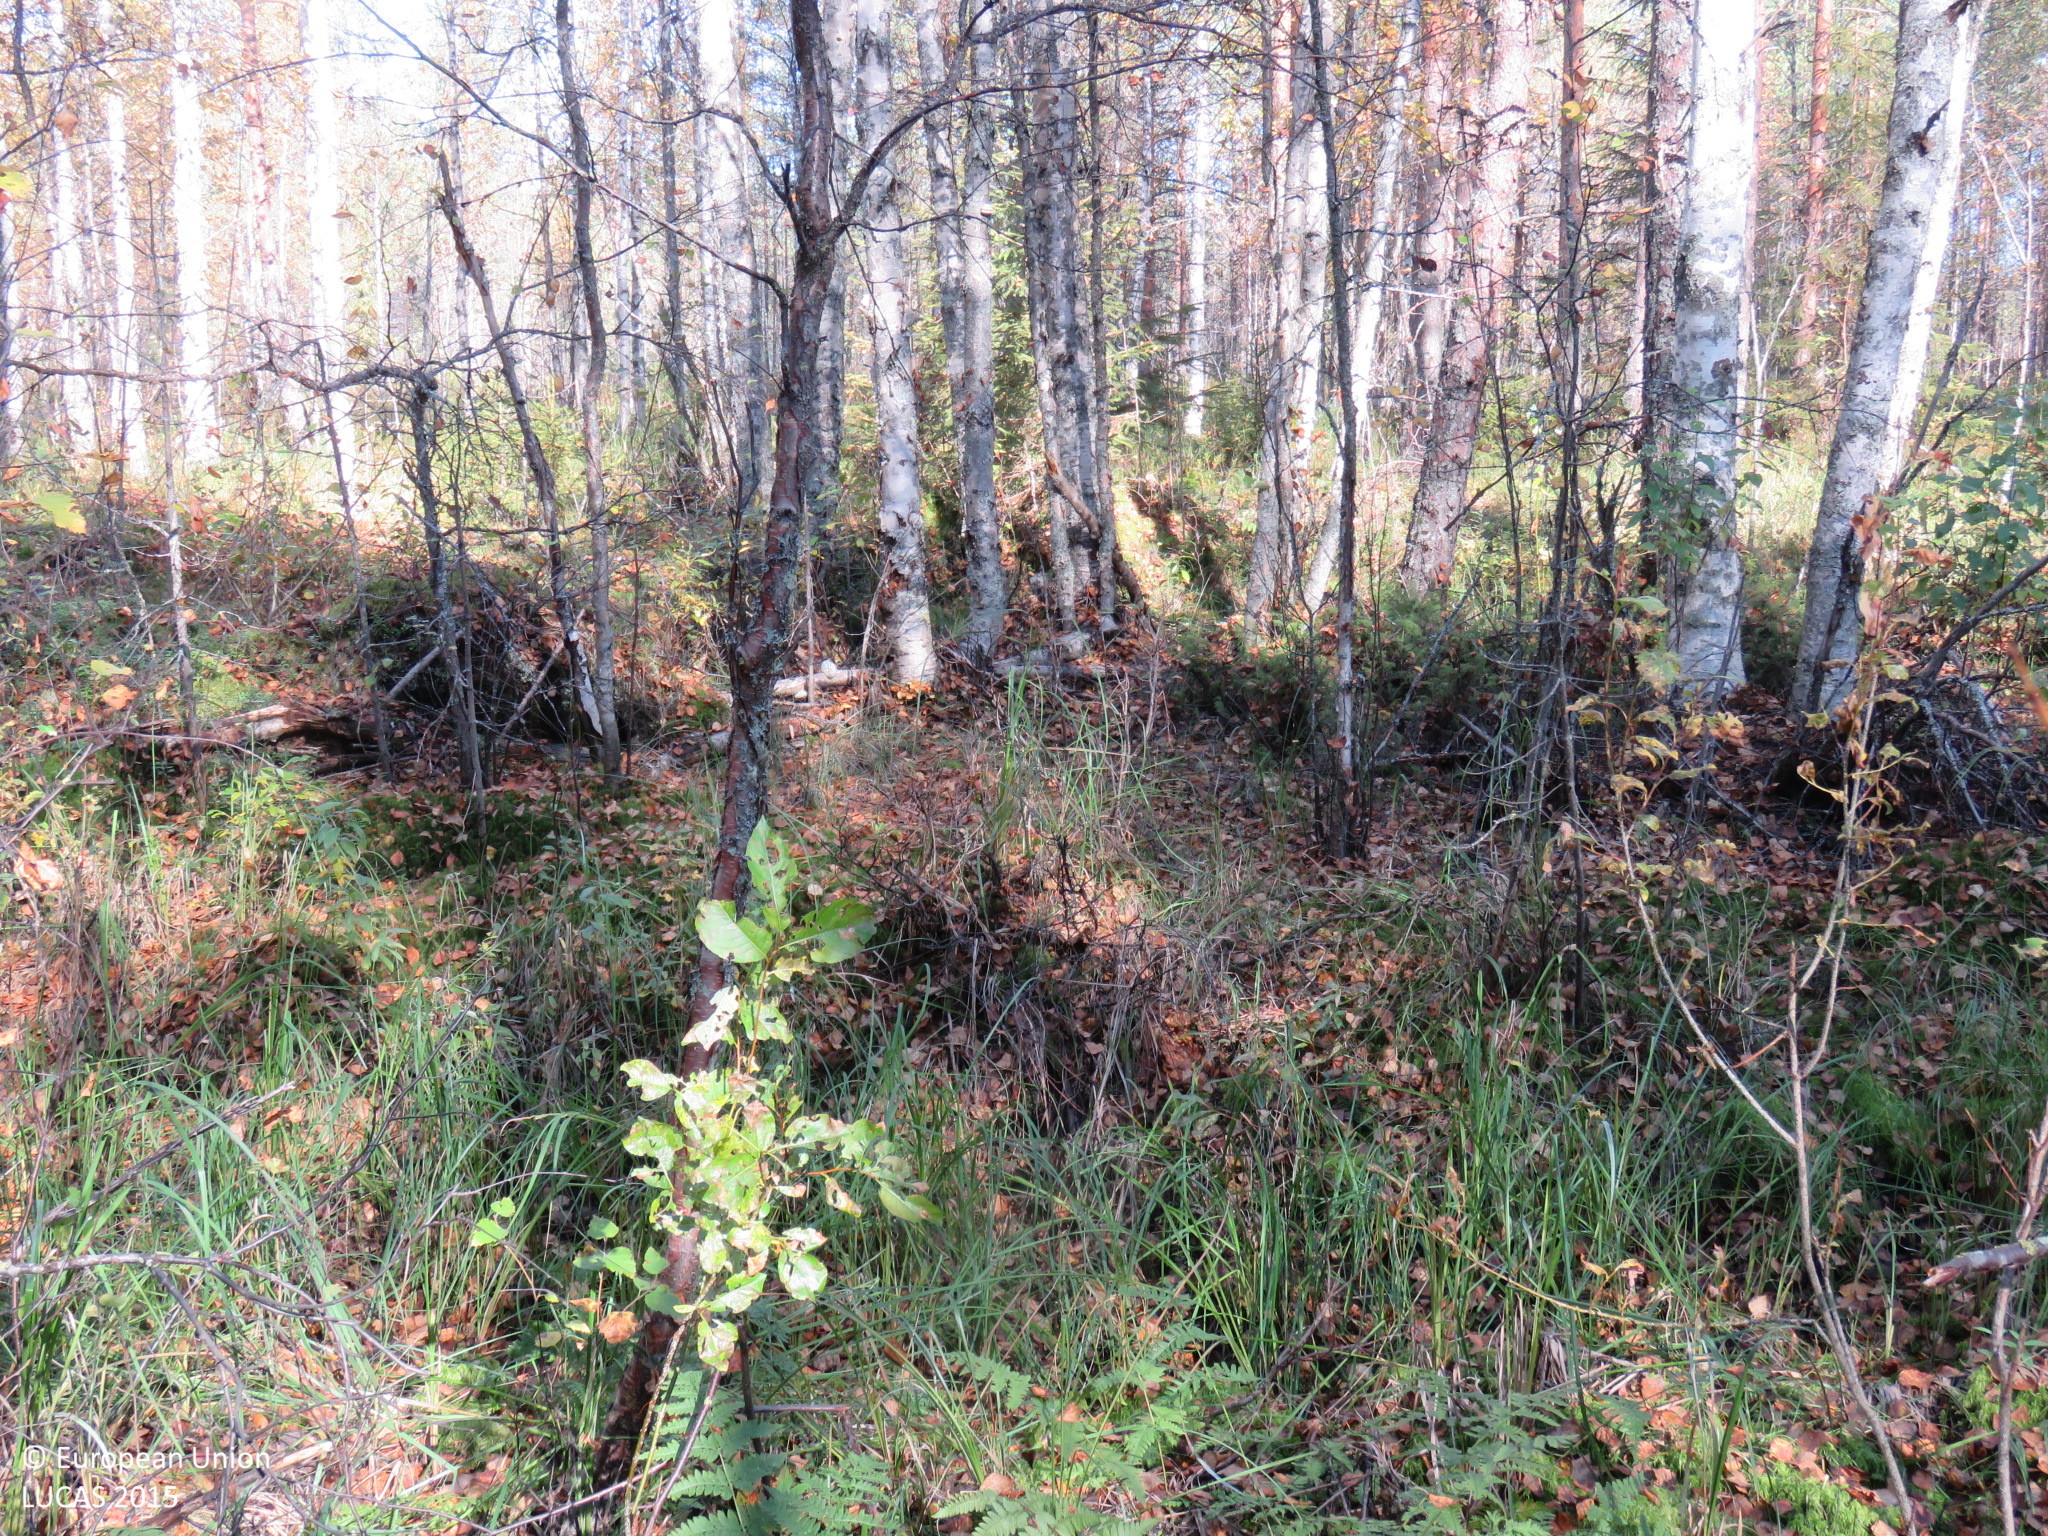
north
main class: Woodland
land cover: Broadleaved woodland
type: mire and swamp forests
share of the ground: > 75 %
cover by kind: broadleaved forest trees 75 %, coniferous forest trees 10 %, herbaceous plants 10 %, lichens and mosses 5 %
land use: Forestry
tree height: > 5 m
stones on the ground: < 10 %
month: September
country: FI
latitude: 64.9441
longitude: 26.9450
